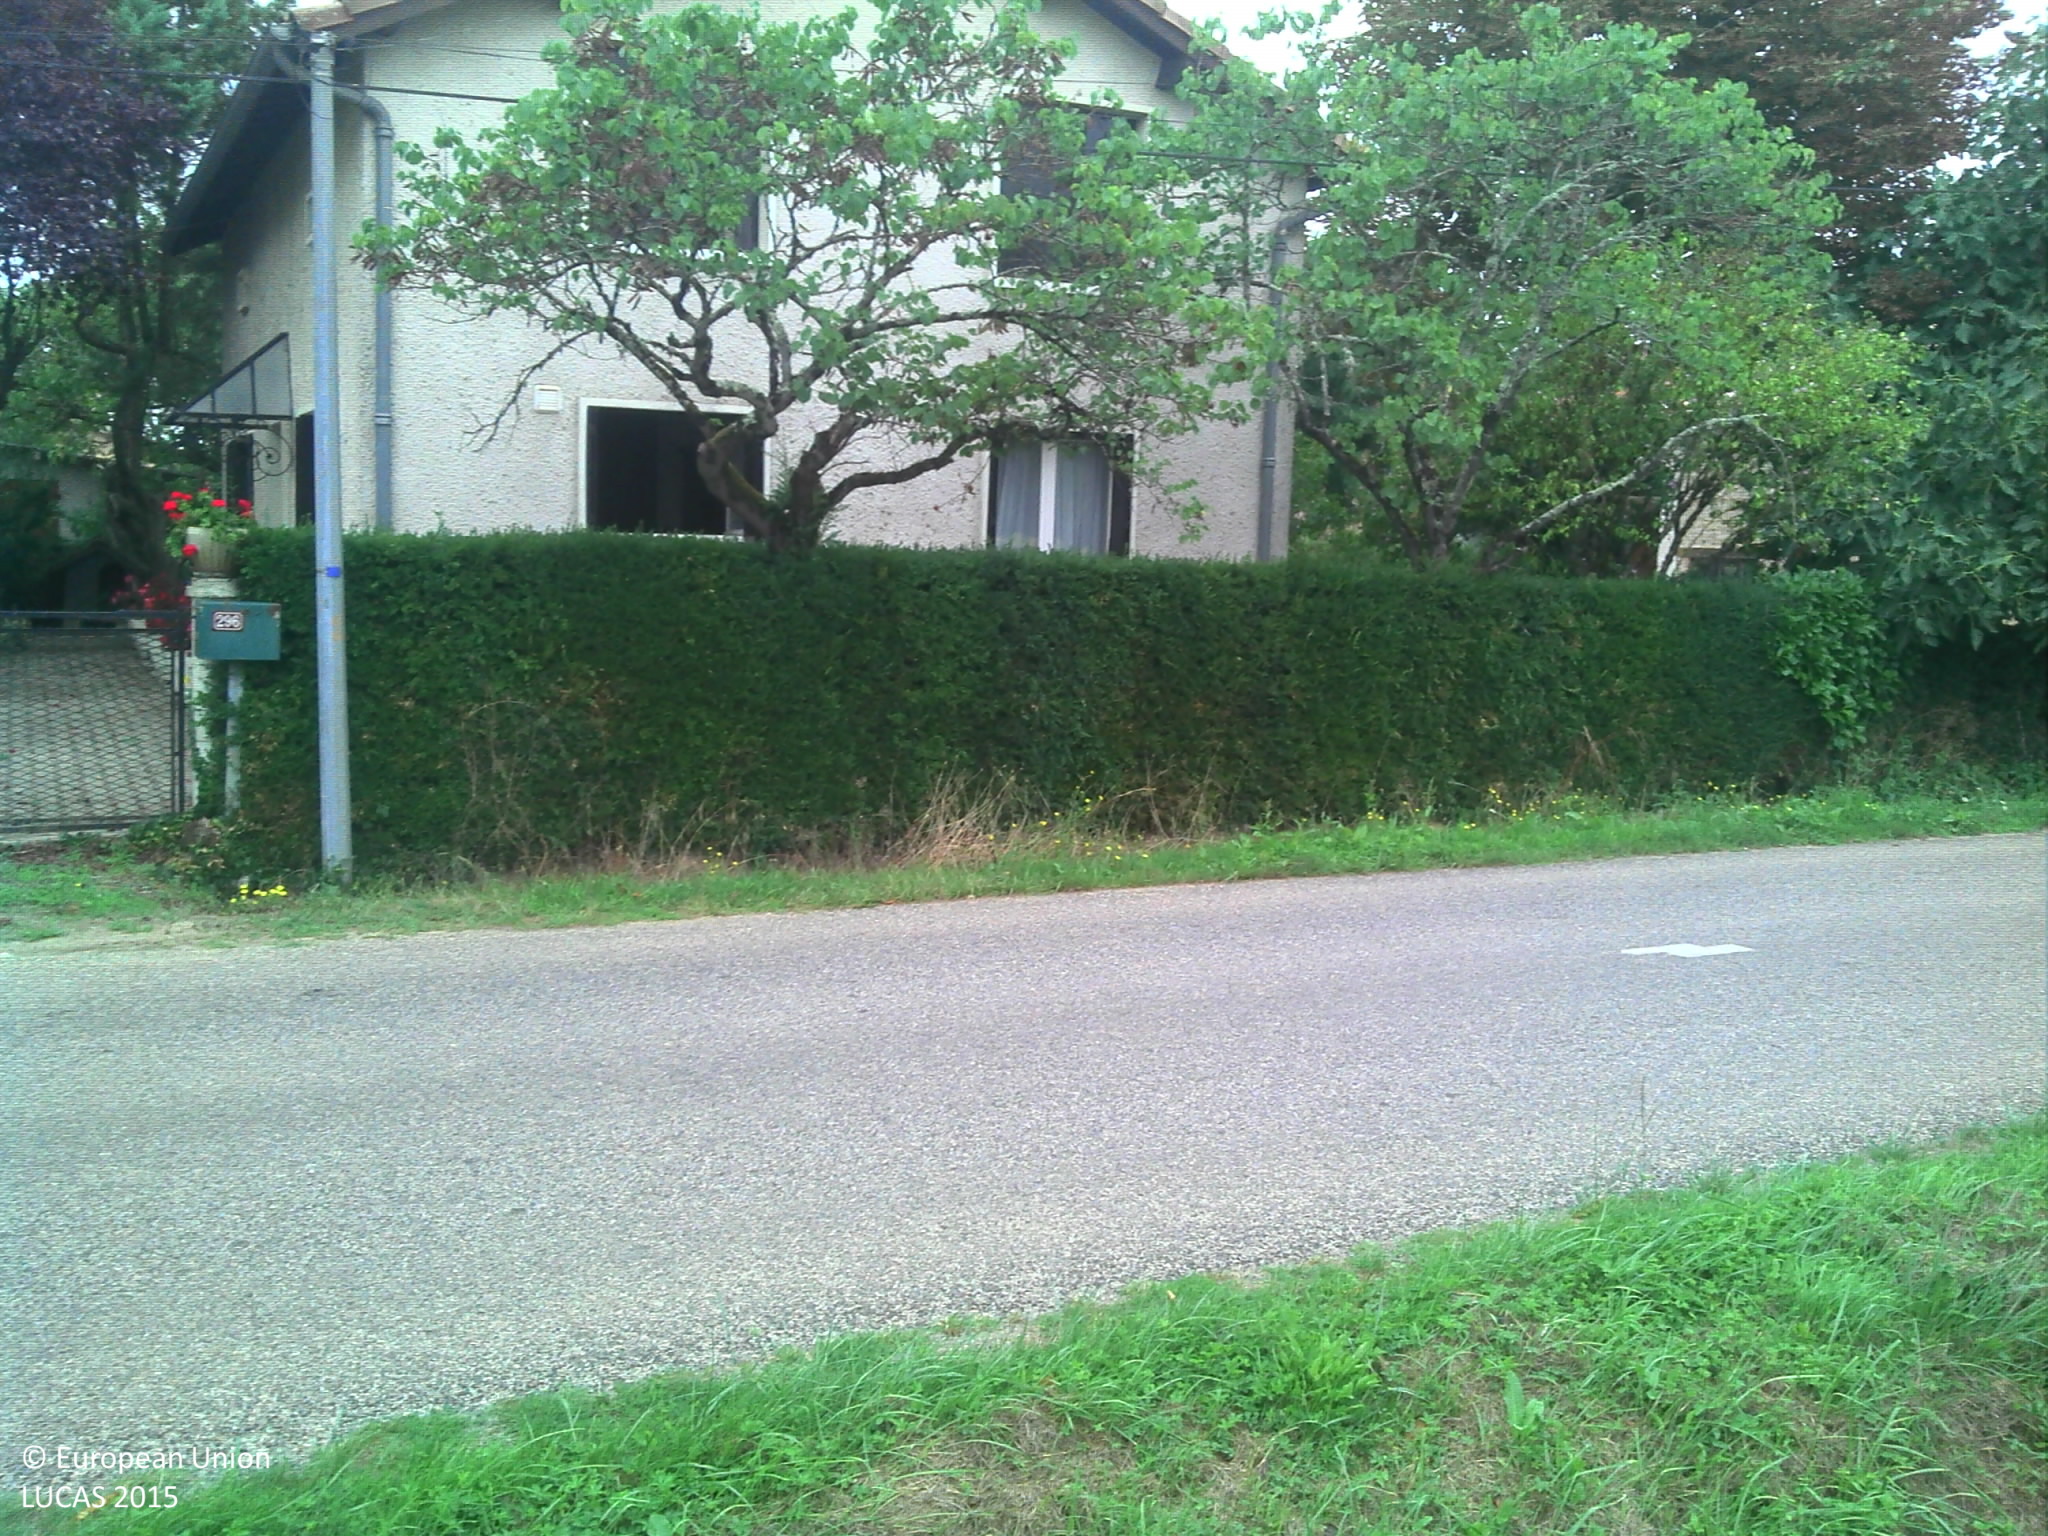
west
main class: Cropland
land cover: Sunflower
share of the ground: > 75 %
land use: Agriculture (excluding fallow land and kitchen gardens)
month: August
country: FR
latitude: 44.0707
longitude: 1.2466
